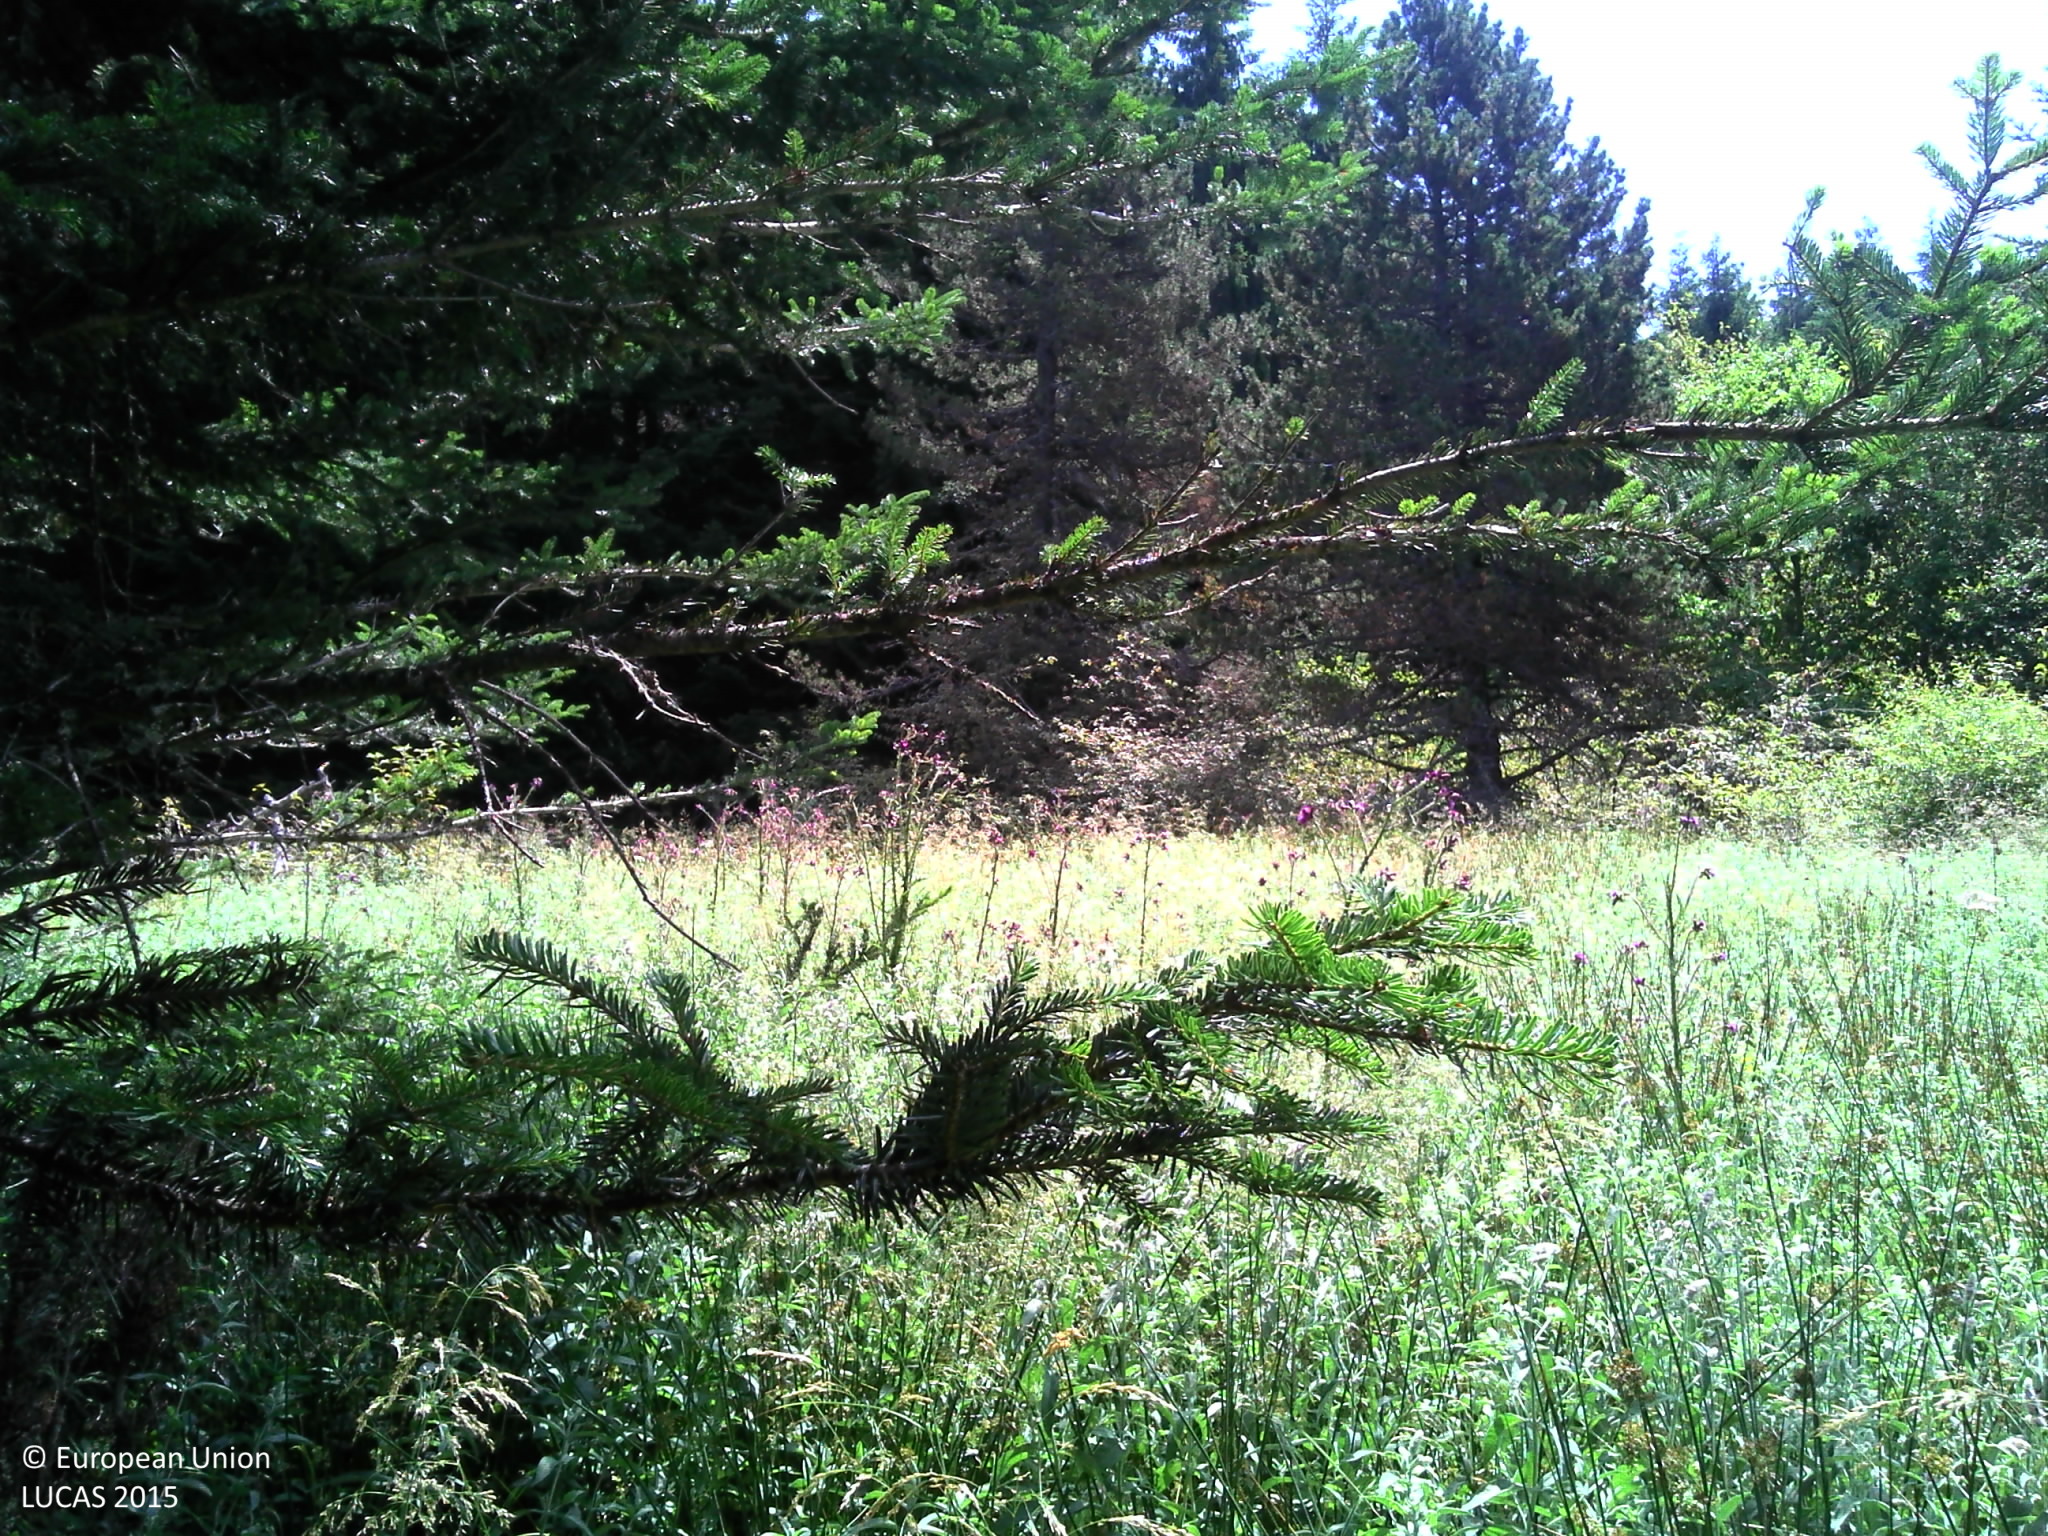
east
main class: Woodland
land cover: Other mixed woodland
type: alpine coniferous forest
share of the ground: > 75 %
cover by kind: herbaceous plants 55 %, coniferous forest trees 30 %, broadleaved forest trees 15 %
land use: Forestry
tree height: > 5 m
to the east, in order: Other mixed woodland; Grassland without tree/shrub cover; Spruce dominated coniferous woodland; Grass margins; Tracks; Grassland without tree/shrub cover; Fences; Tracks; Pine dominated mixed woodland; Other mixed woodland; Spruce dominated mixed woodland; Tracks; Other mixed woodland
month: July
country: FR
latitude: 42.6567
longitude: 2.1421
